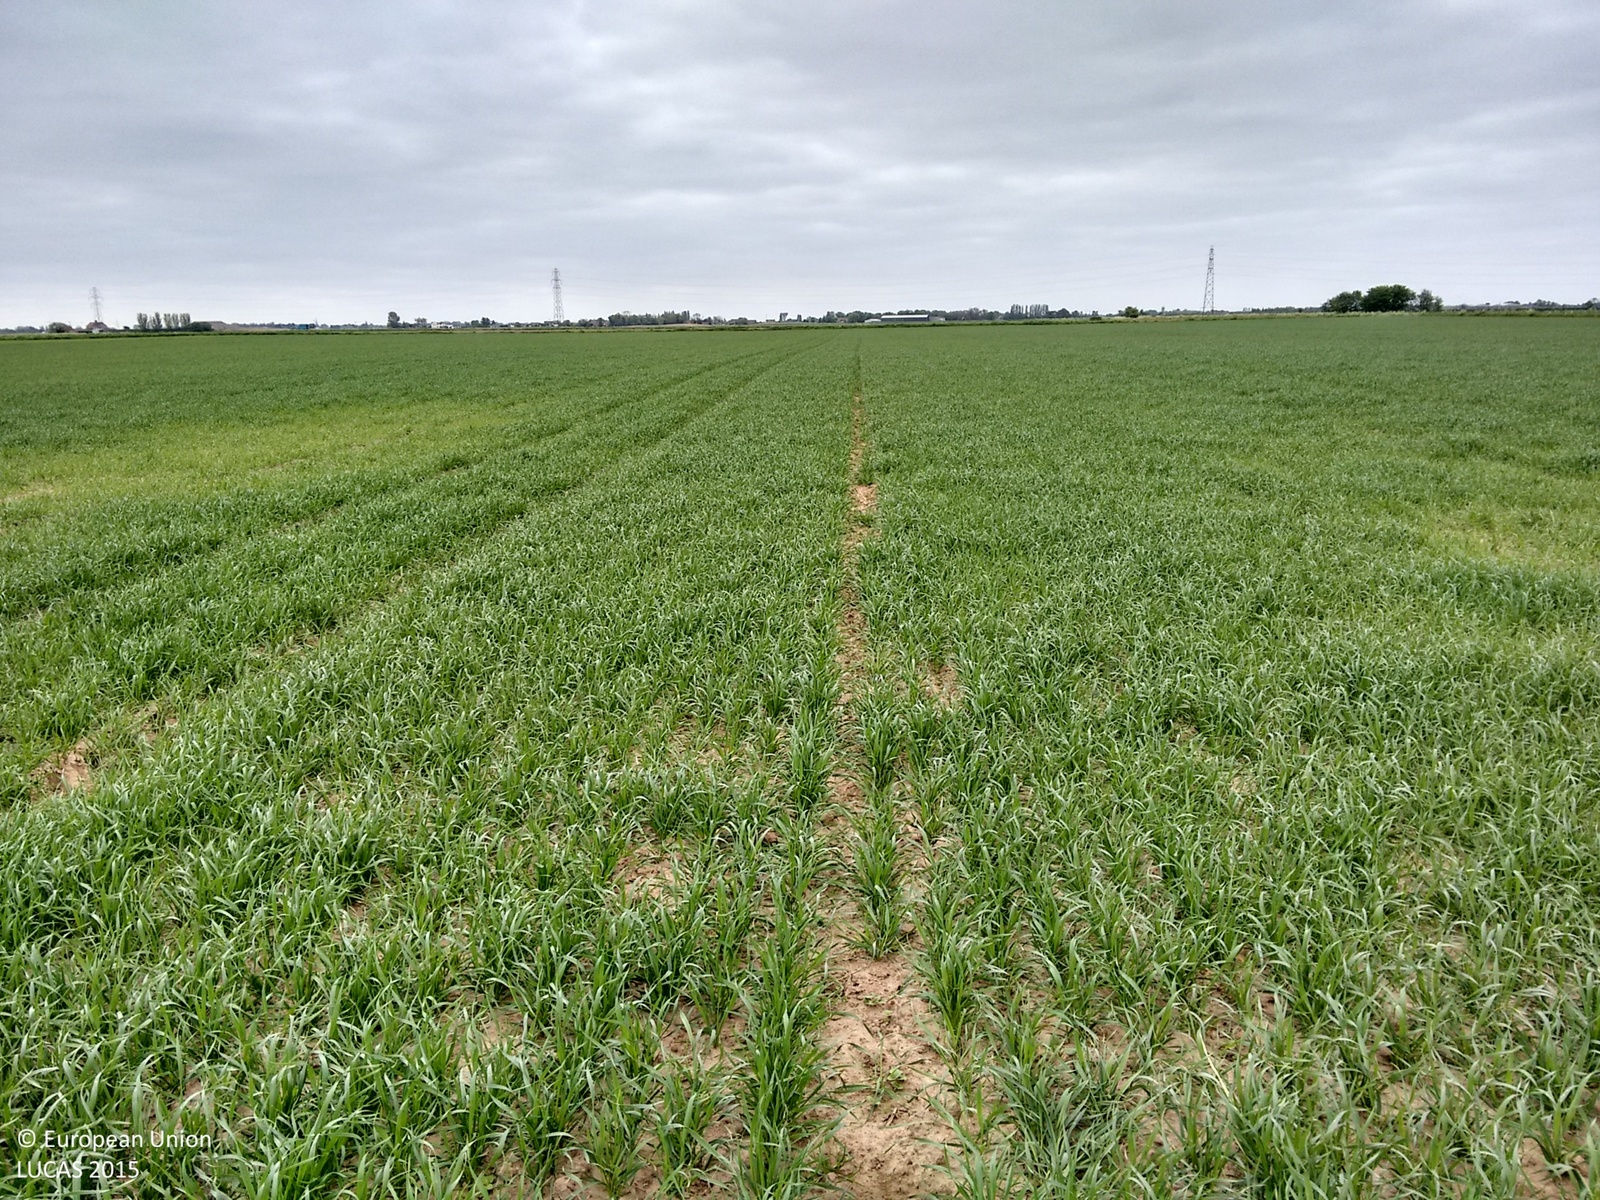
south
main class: Cropland
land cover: Common wheat
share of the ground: > 75 %
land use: Agriculture (excluding fallow land and kitchen gardens)
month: May
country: GB
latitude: 52.8321
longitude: 0.0981
